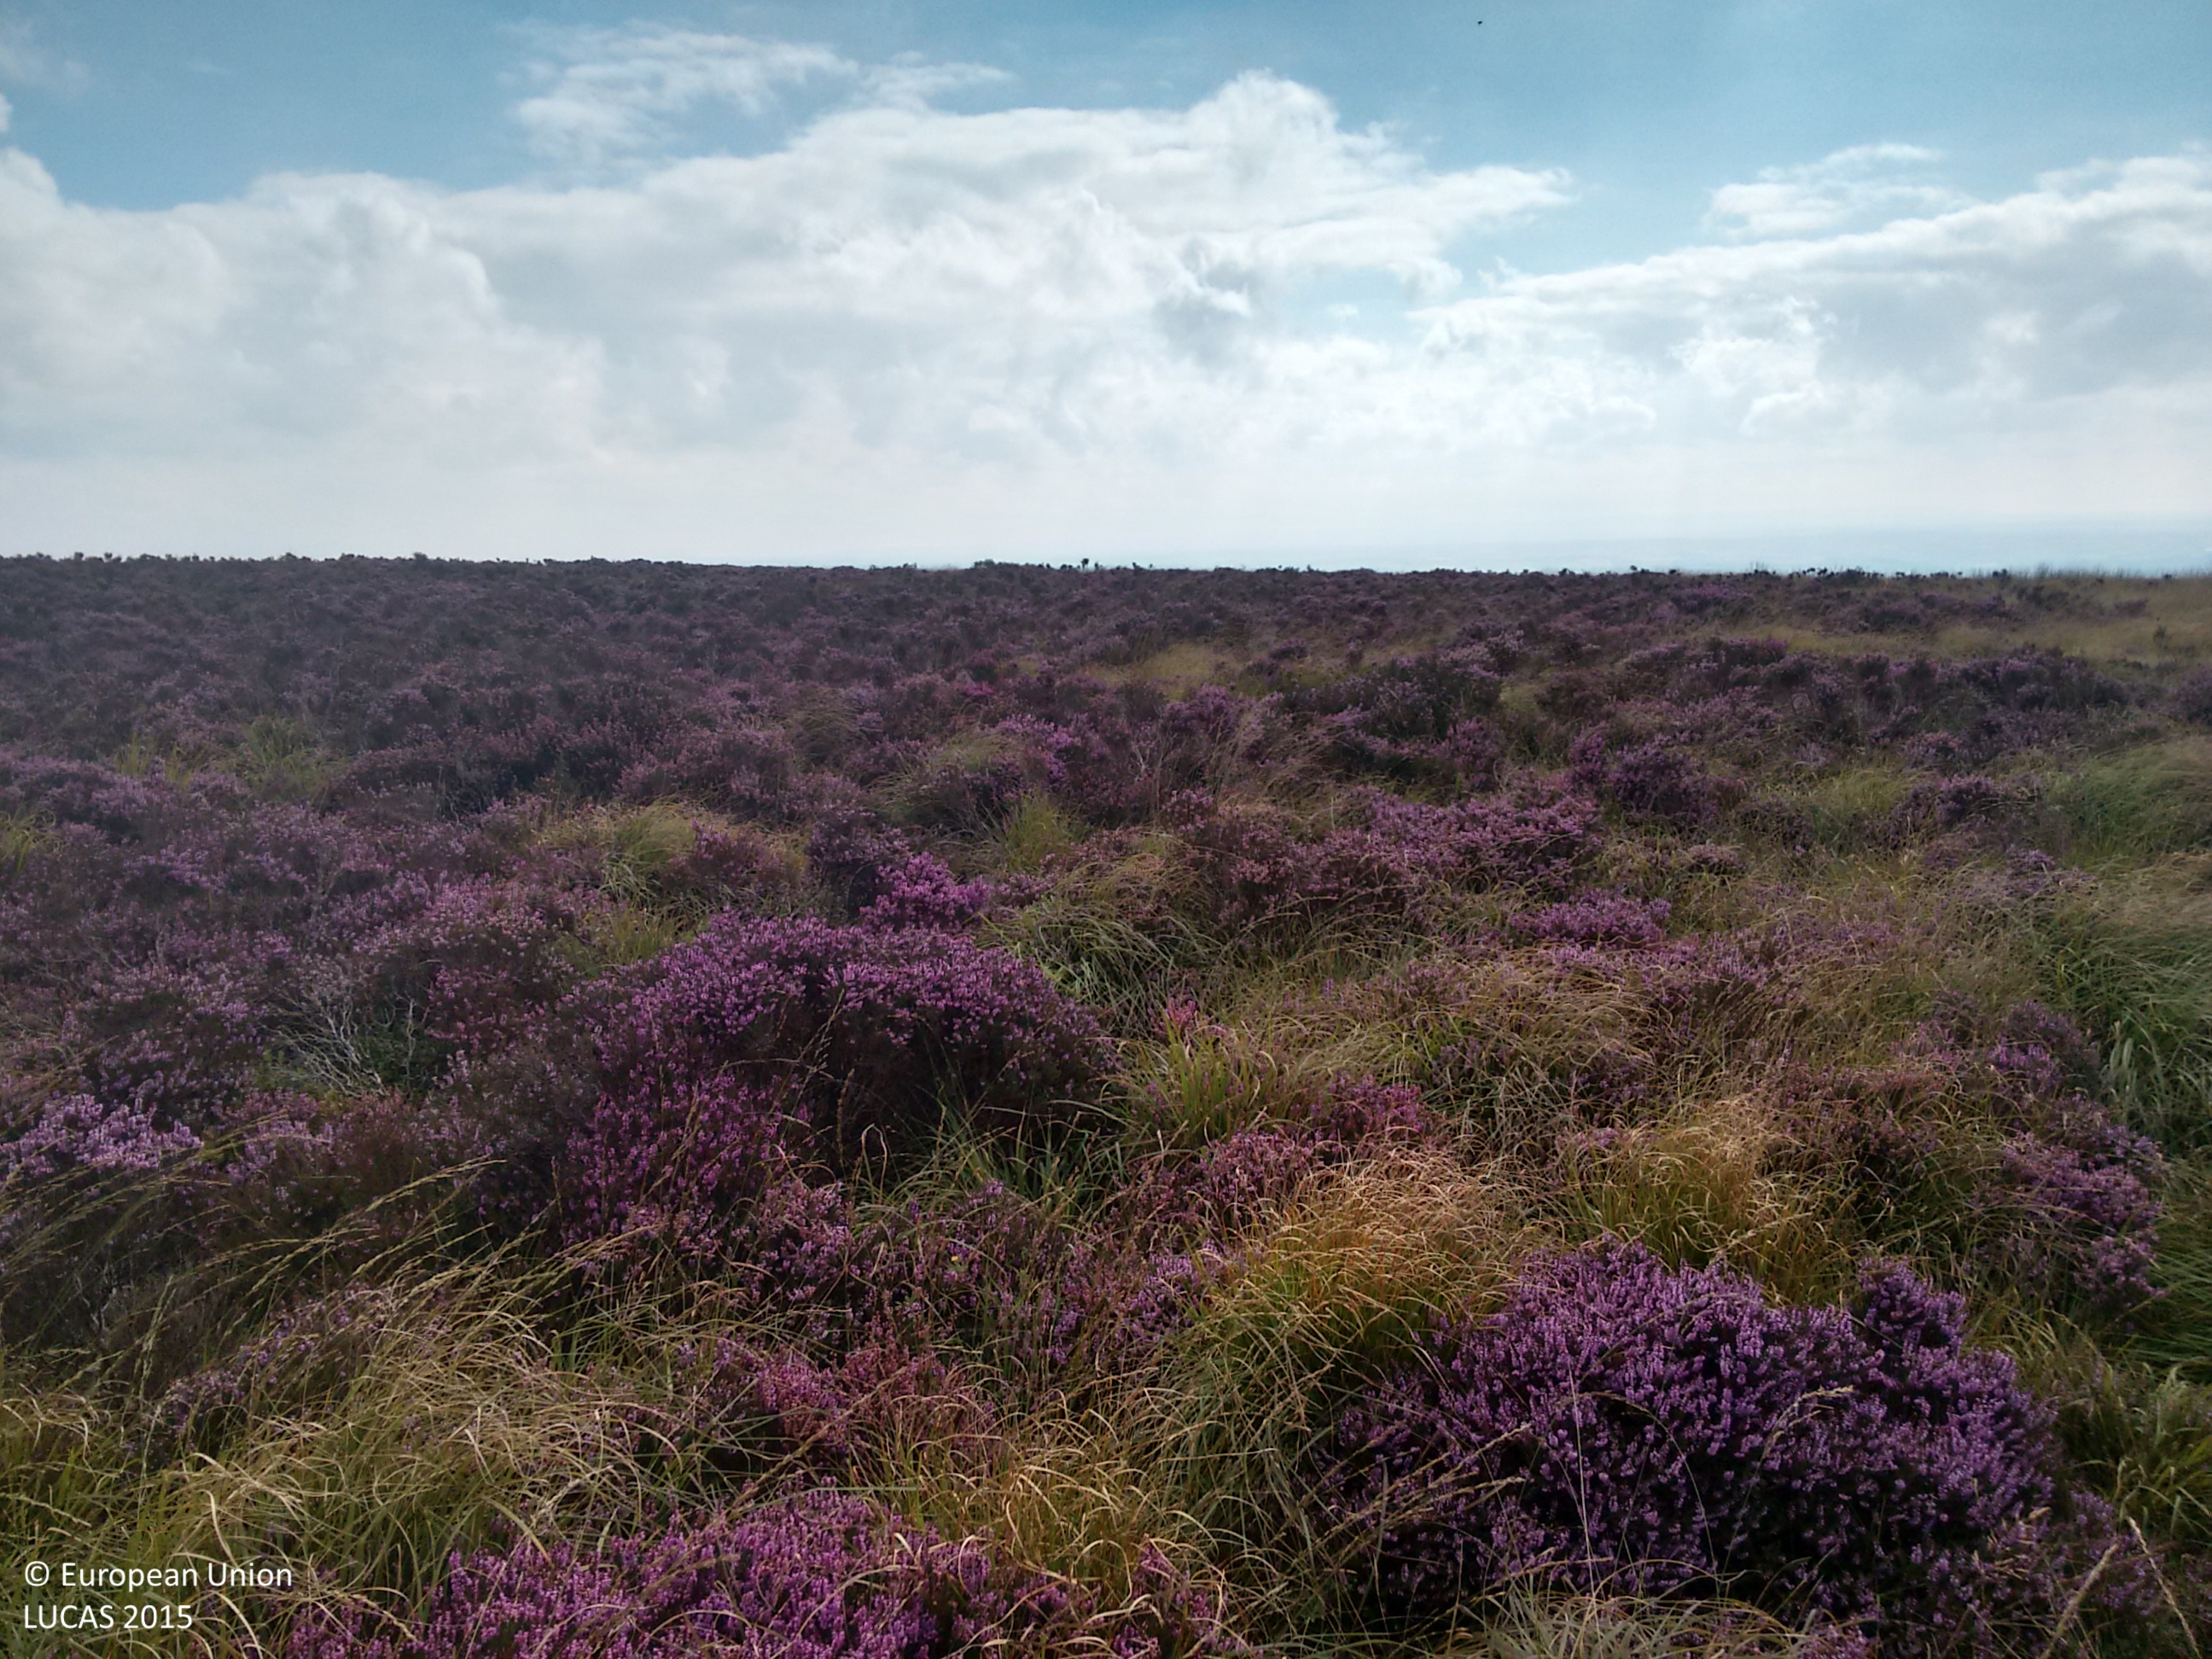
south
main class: Shrubland
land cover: Shrubland without tree cover
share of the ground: > 75 %
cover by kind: shrubs 80 %, herbaceous plants 20 %
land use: Agriculture (excluding fallow land and kitchen gardens)
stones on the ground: 10 - 25 %
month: September
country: GB
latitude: 51.0796
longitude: -3.7496
